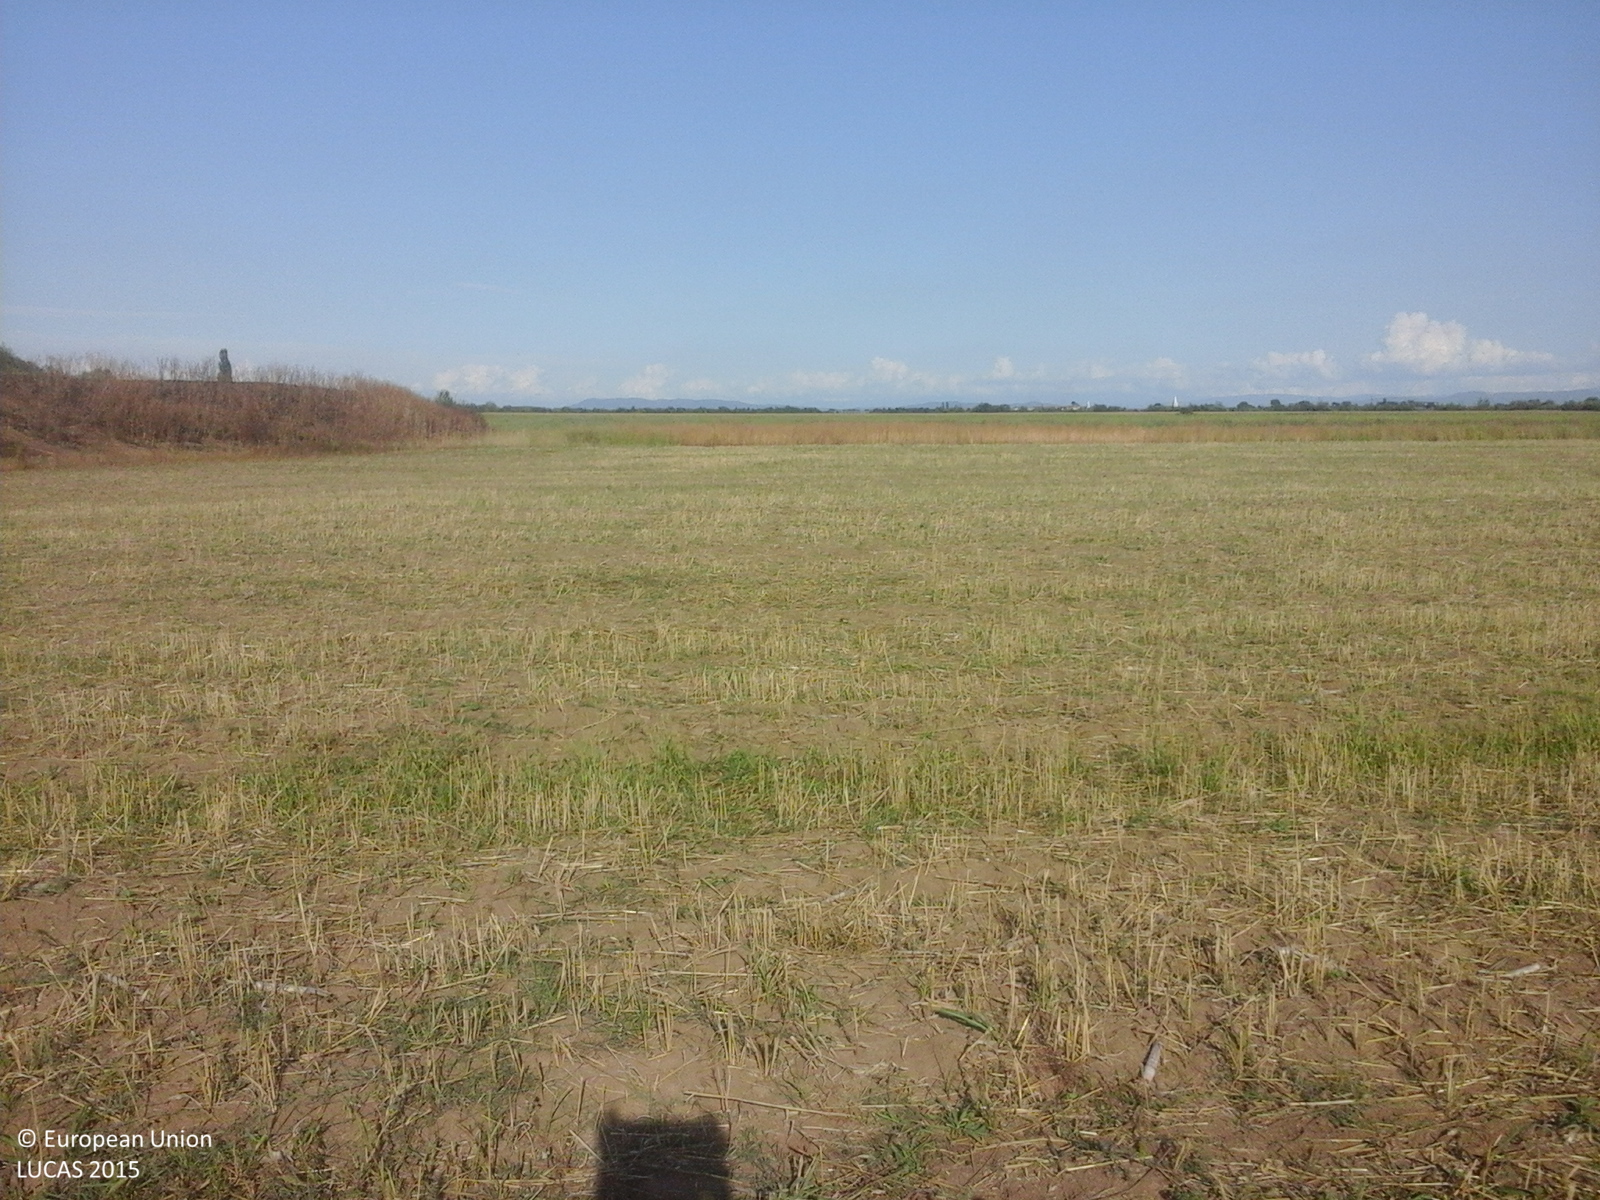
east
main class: Cropland
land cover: Maize
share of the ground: > 75 %
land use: Agriculture (excluding fallow land and kitchen gardens)
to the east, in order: Maize; Common wheat; Spontaneously vegetated surfaces
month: August
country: RO
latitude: 45.4311
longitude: 21.3939
